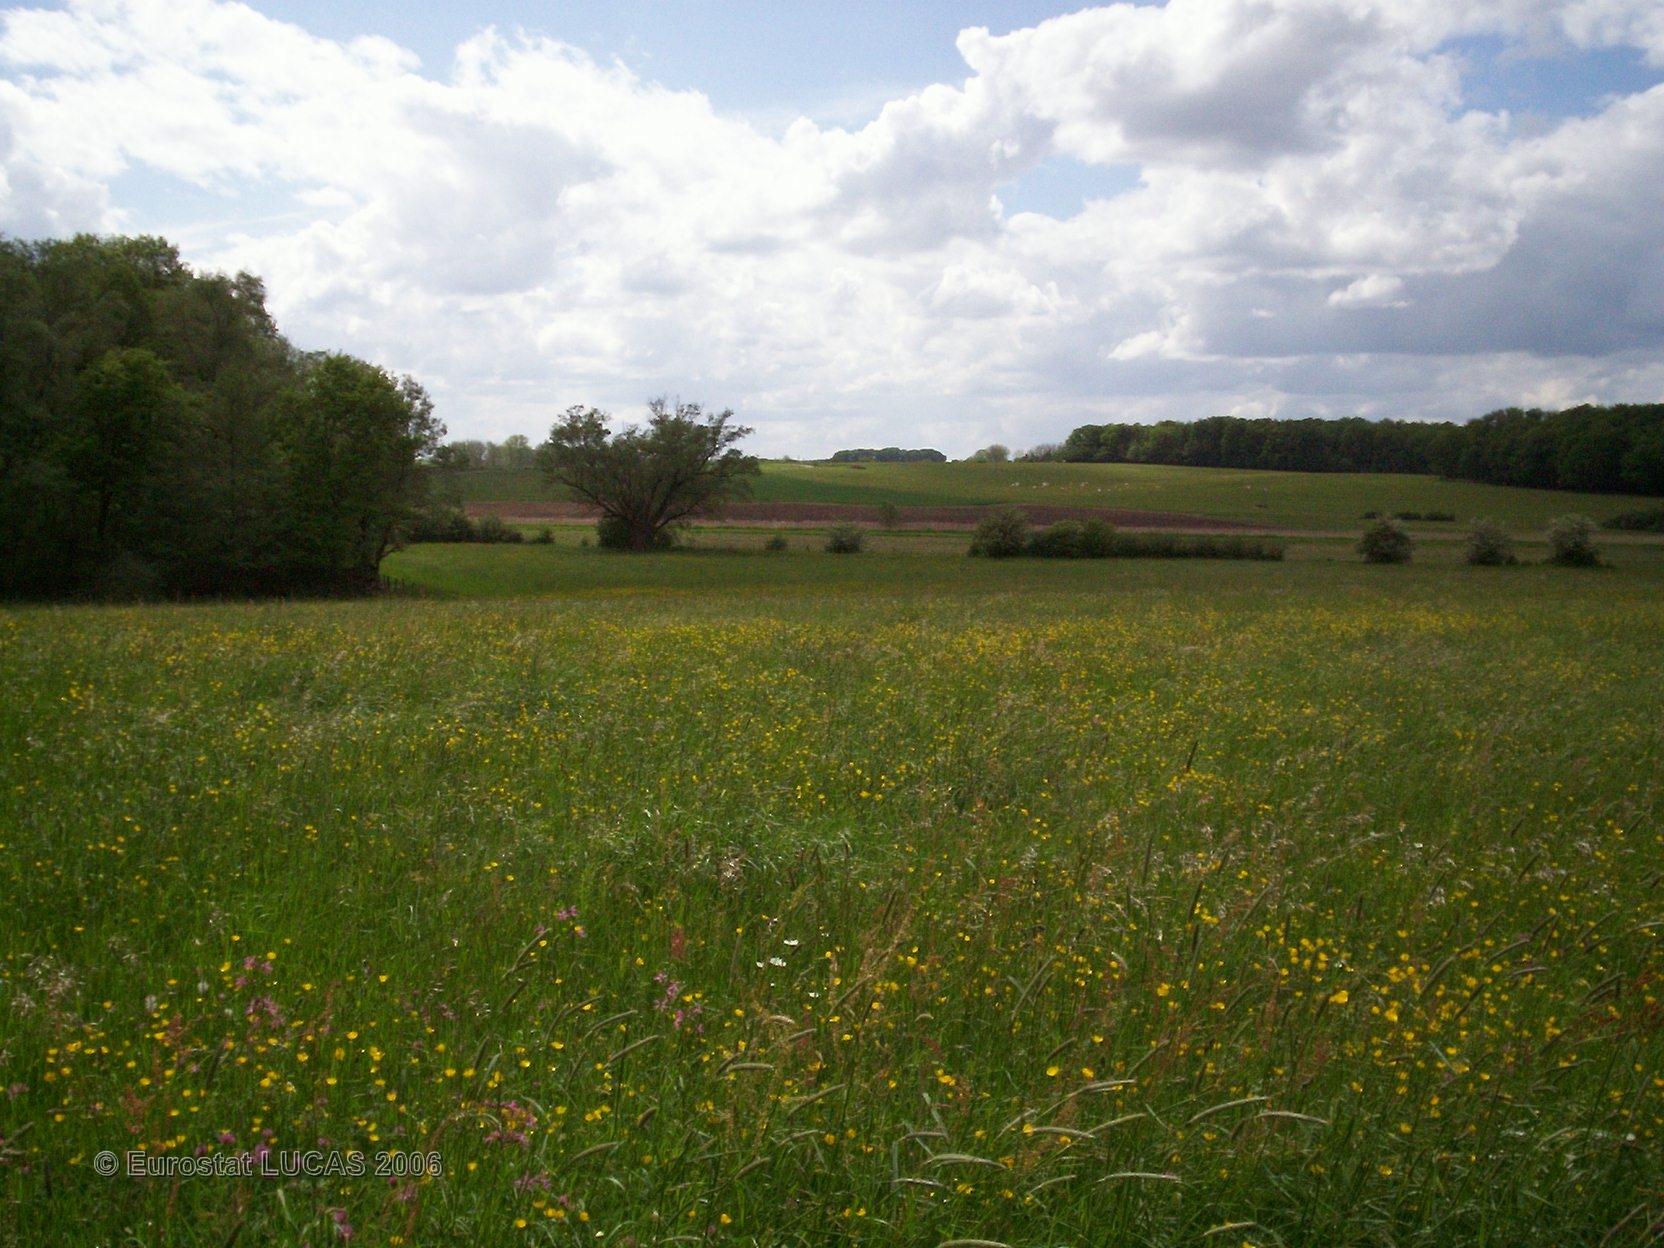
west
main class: Grassland
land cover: Grassland without tree/shrub cover
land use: Agriculture (excluding fallow land and kitchen gardens)
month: May
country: FR
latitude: 48.6089
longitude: 6.7862
